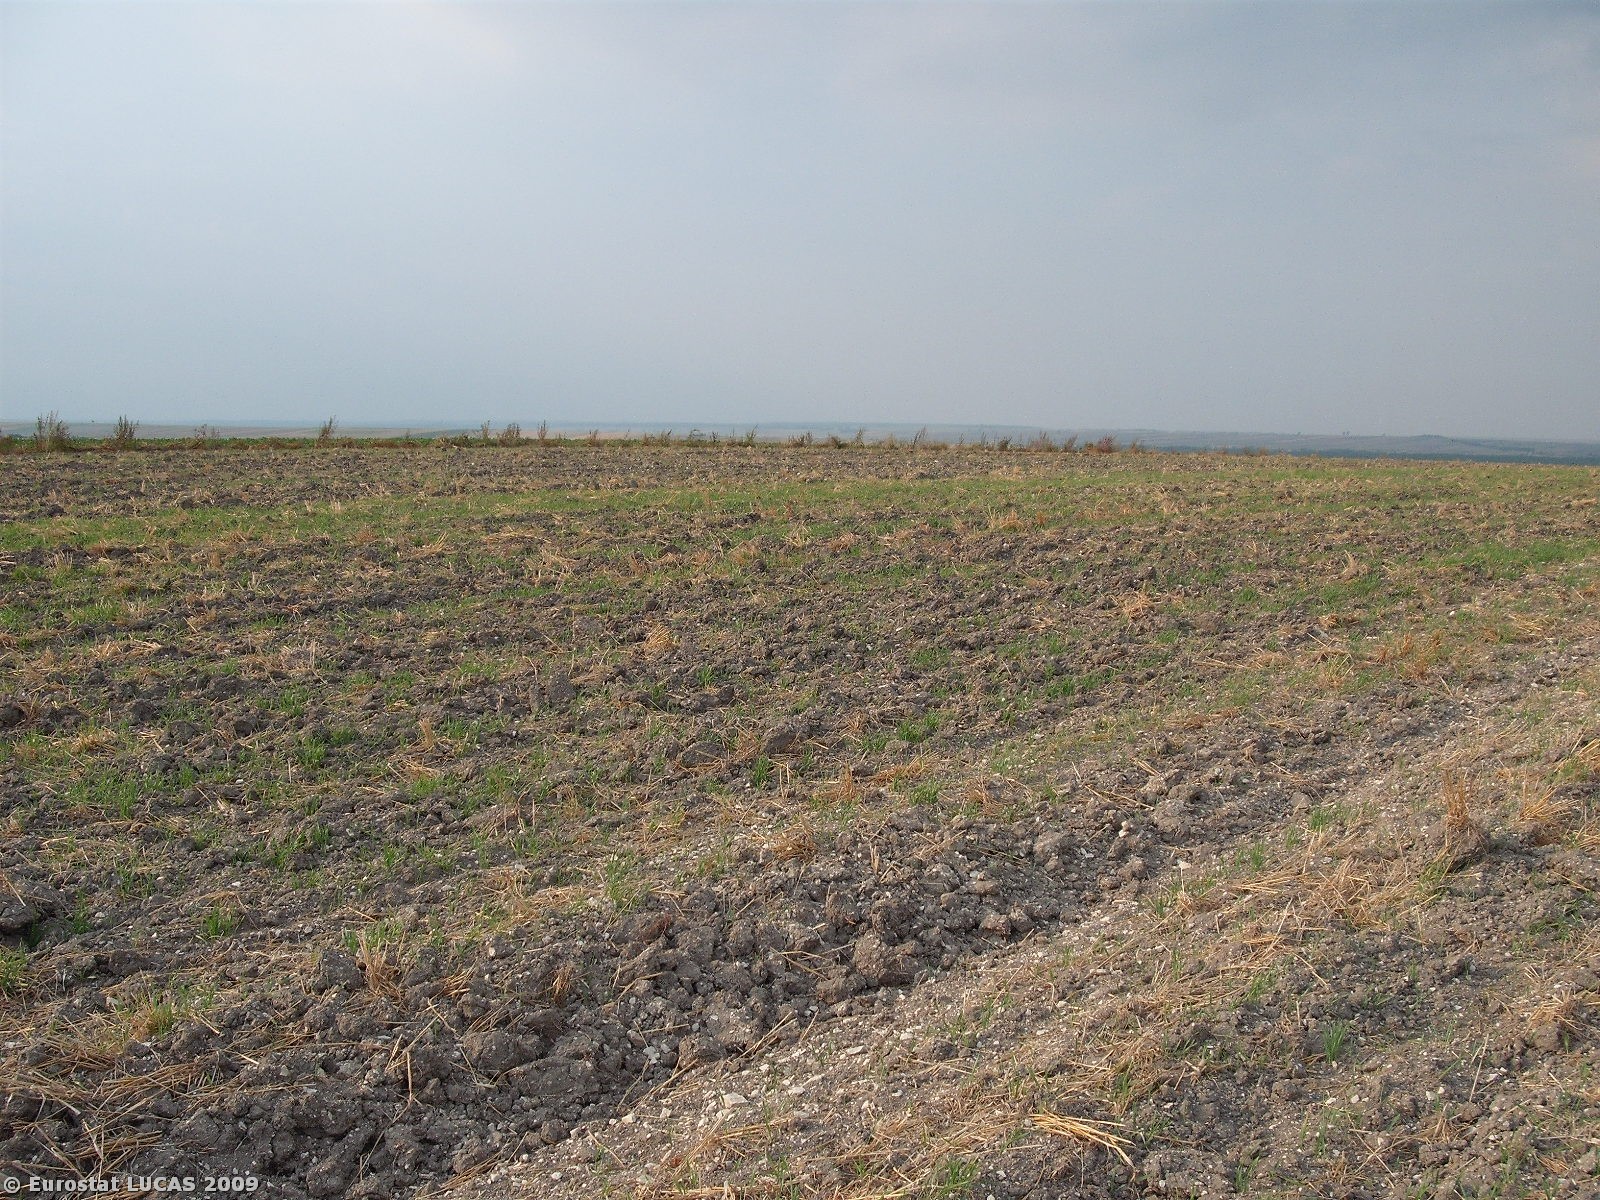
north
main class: Cropland
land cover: Barley
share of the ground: < 10 %
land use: Agriculture (excluding fallow land and kitchen gardens)
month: September
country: PL
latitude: 50.4772
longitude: 20.3086
